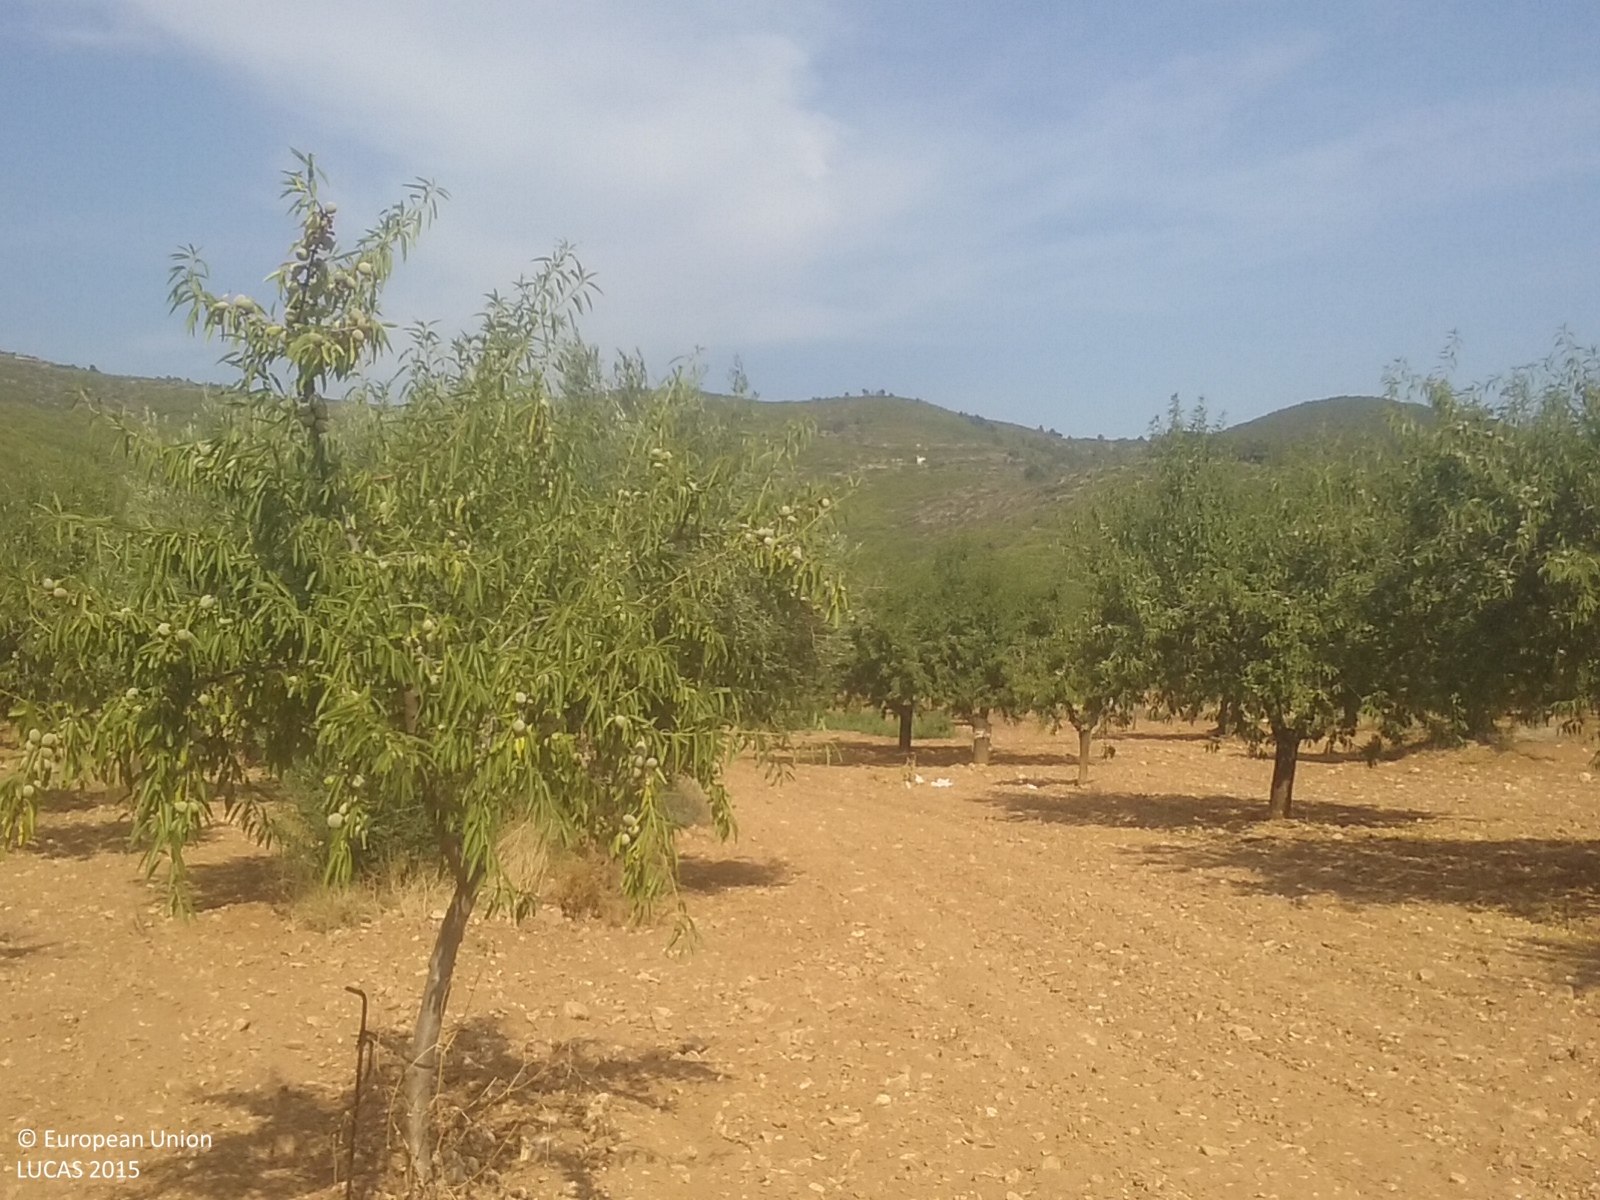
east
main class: Cropland
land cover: Nuts trees
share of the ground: 50 - 75 %
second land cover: Other bare soil
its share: > 75 %
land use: Agriculture (excluding fallow land and kitchen gardens)
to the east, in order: Nuts trees; Other bare soil; Single bushes/trees; Nuts trees; Electric lines; Nuts trees
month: July
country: ES
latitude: 40.2212
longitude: -0.0743
